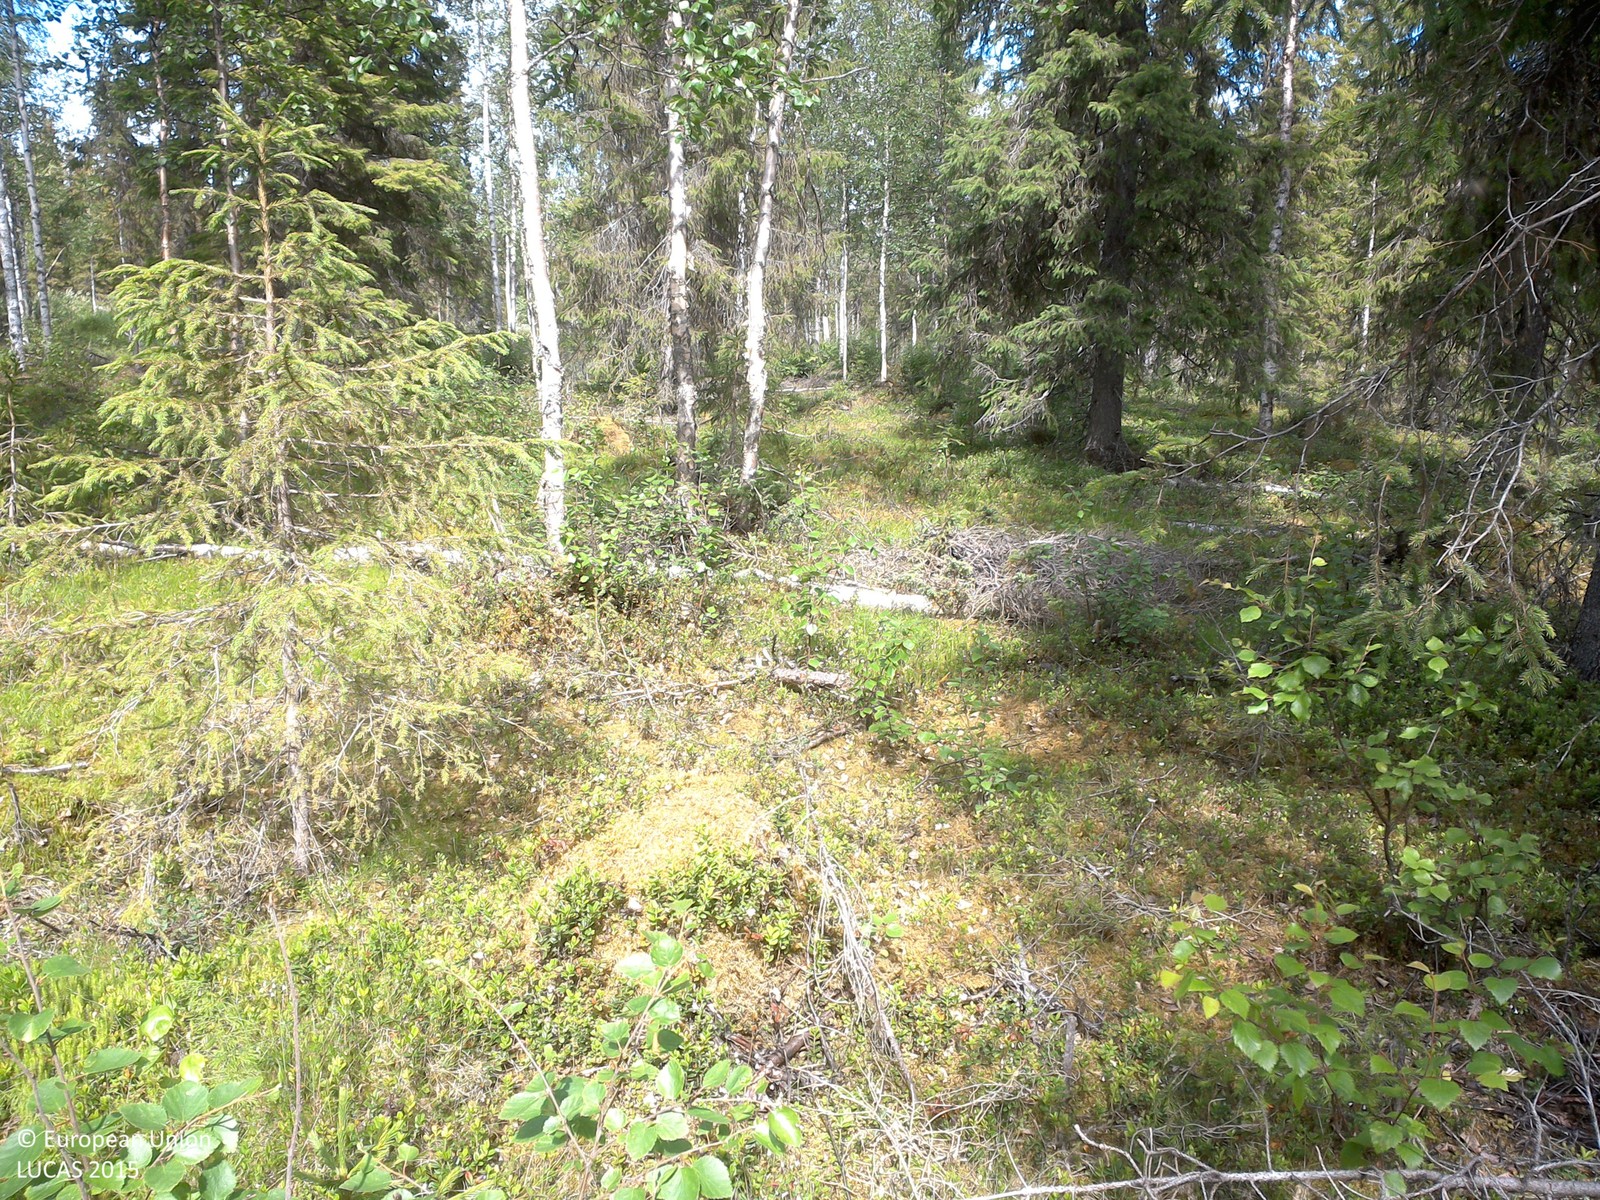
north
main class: Woodland
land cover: Spruce dominated mixed woodland
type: boreal forest
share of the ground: 25 - 50 %
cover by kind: shrubs 45 %, coniferous forest trees 25 %, broadleaved forest trees 10 %, herbaceous plants 10 %, lichens and mosses 10 %
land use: Forestry
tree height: > 5 m
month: July
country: SE
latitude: 67.5237
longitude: 23.4459
